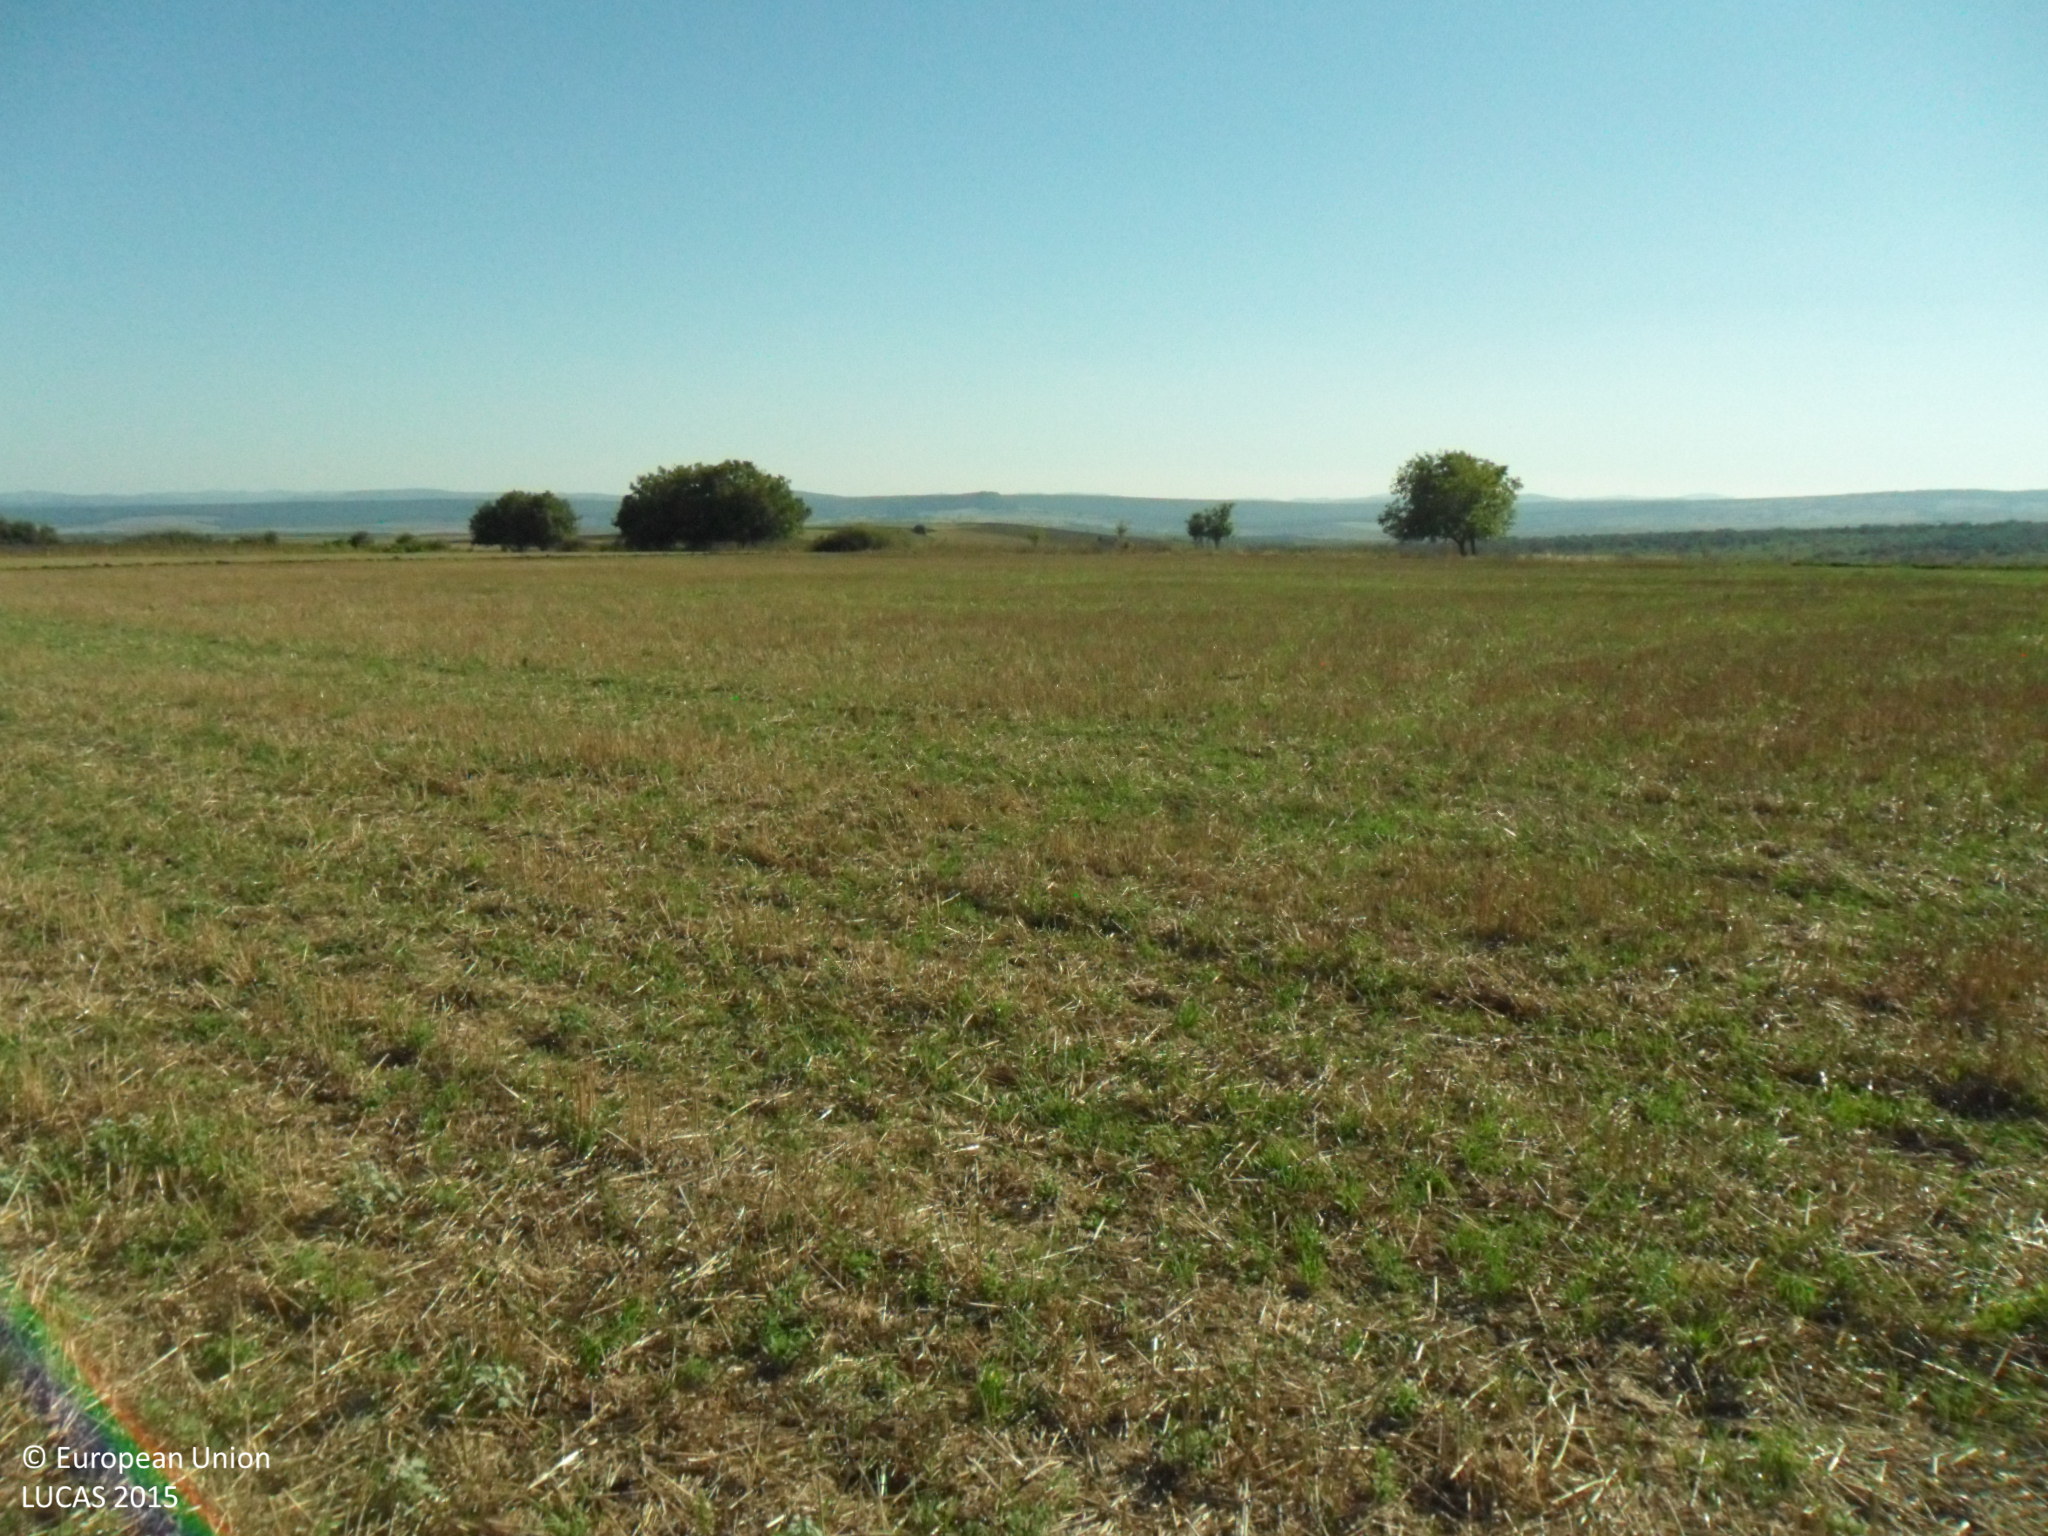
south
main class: Grassland
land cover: Spontaneously vegetated surfaces
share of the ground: > 75 %
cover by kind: herbaceous plants 95 %, shrubs 5 %
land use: Agriculture (excluding fallow land and kitchen gardens)
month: September
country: BG
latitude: 43.1896
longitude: 27.2356
